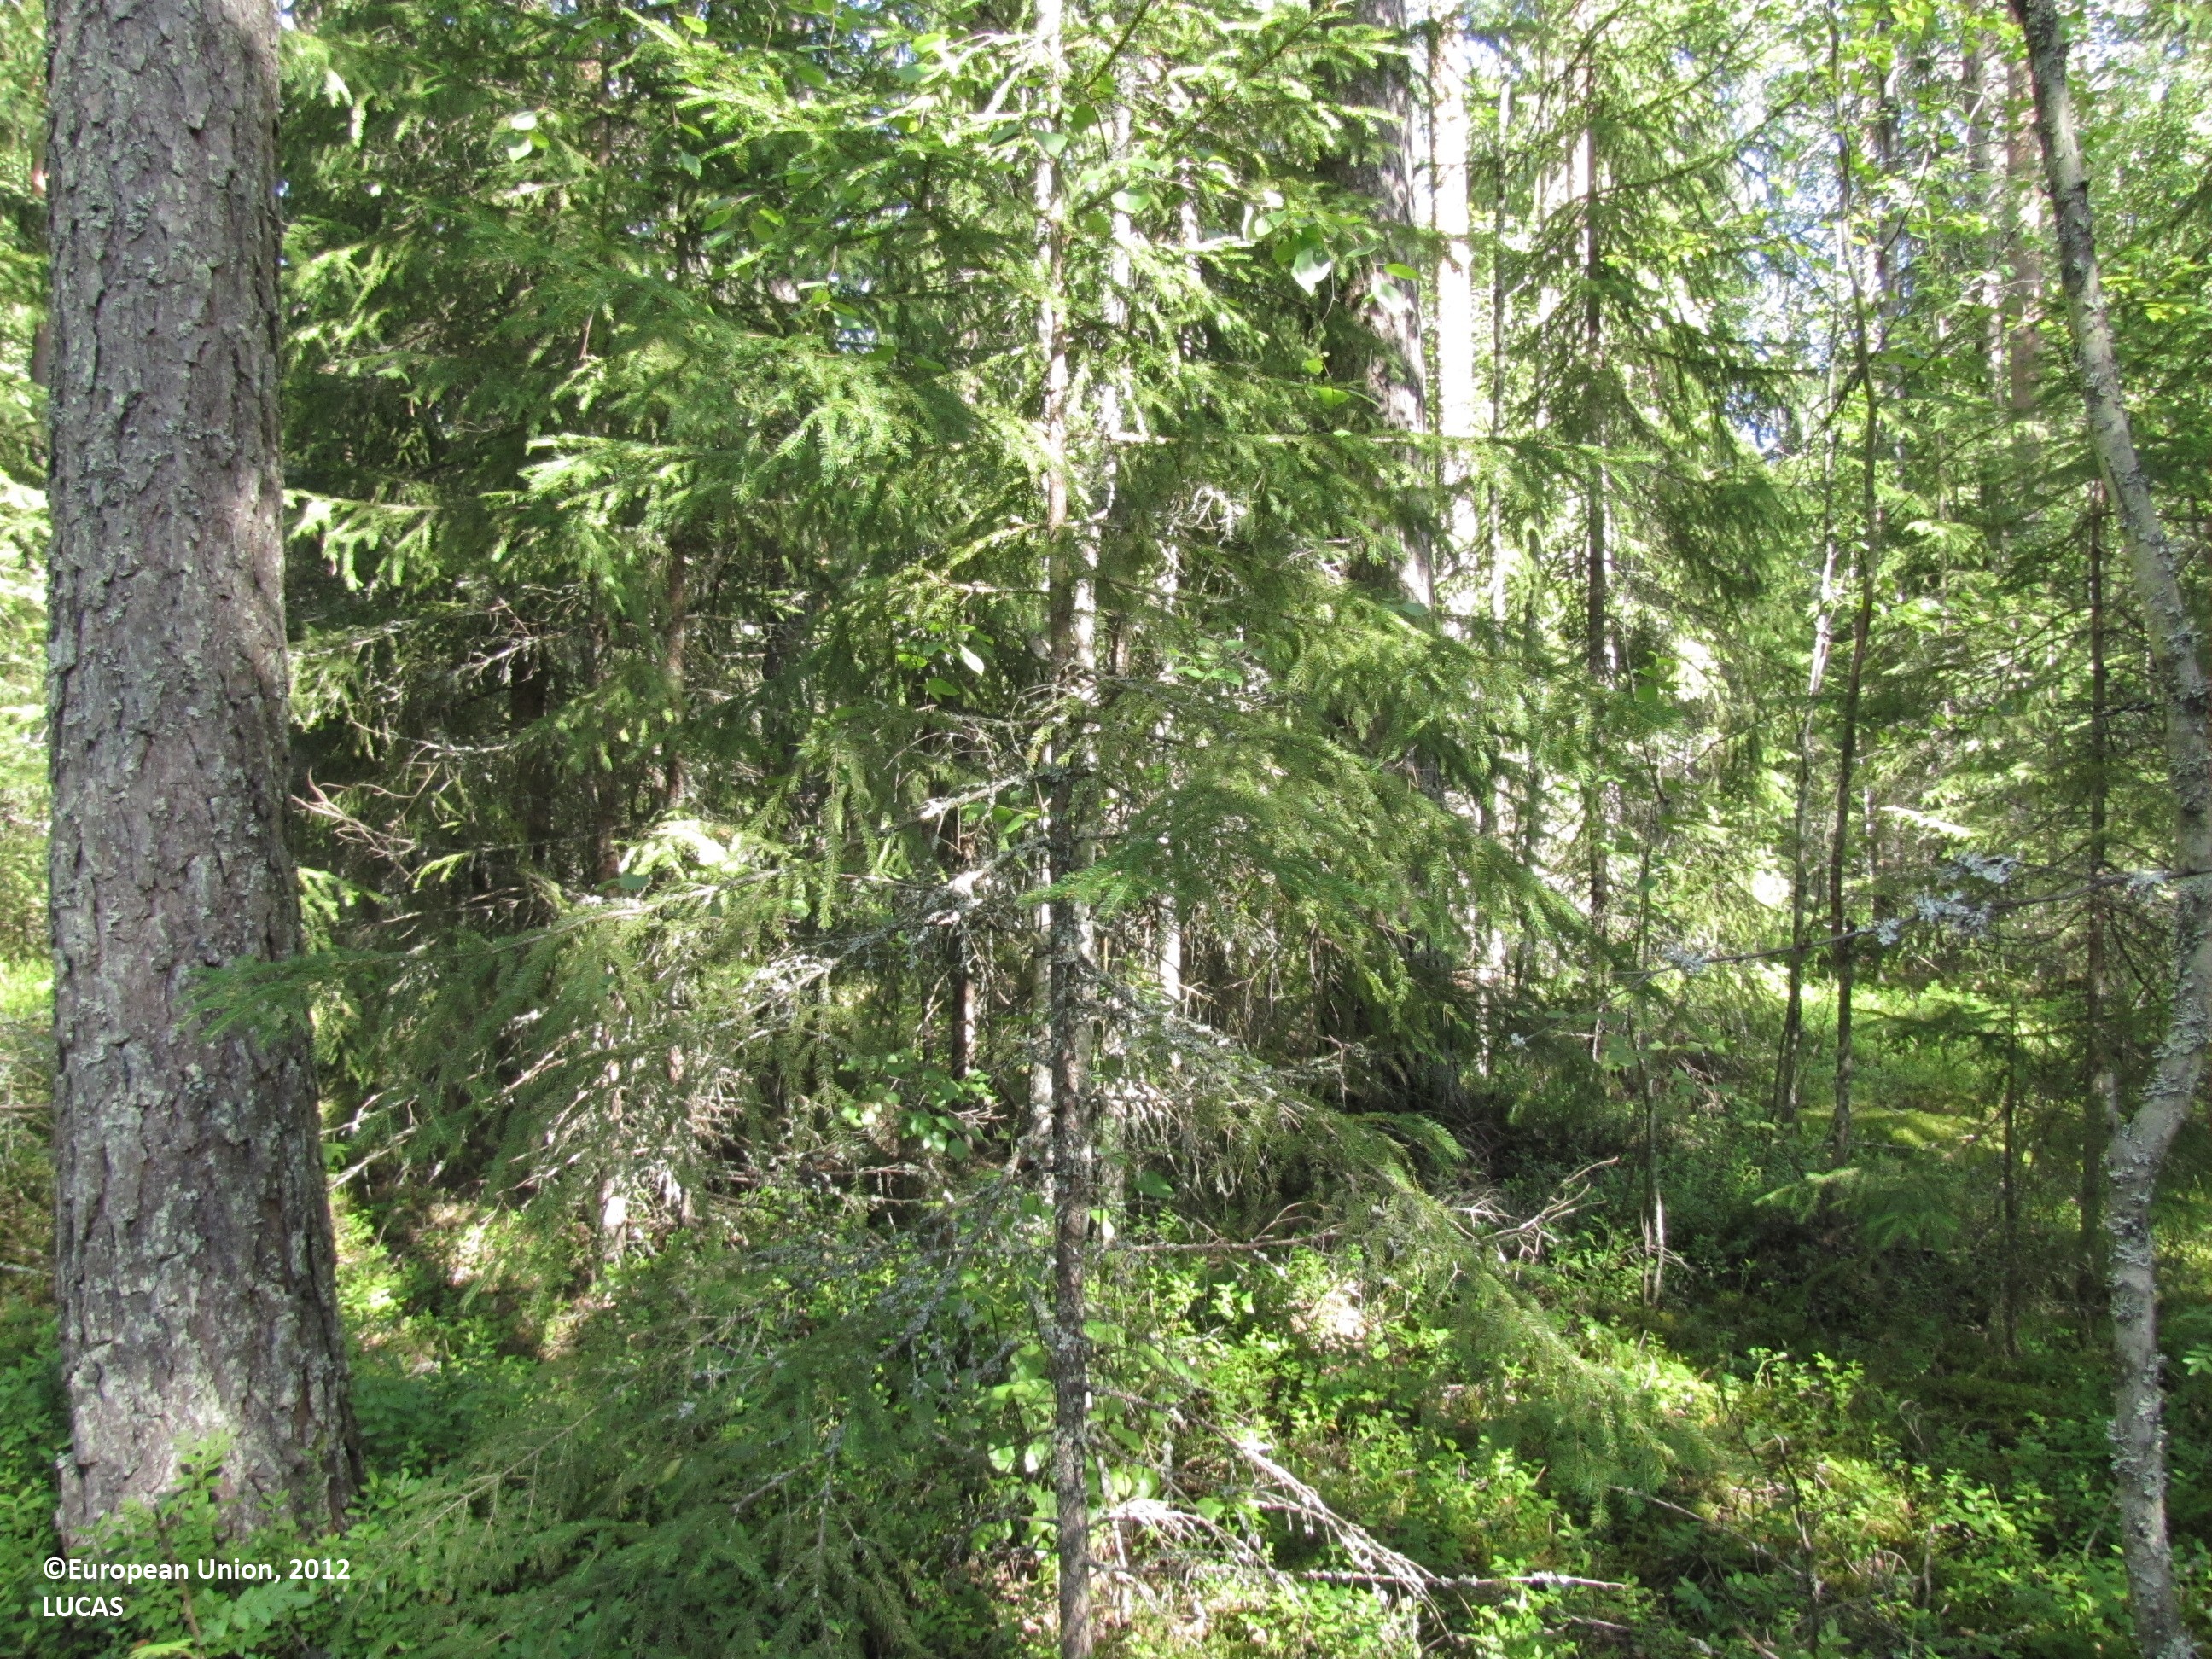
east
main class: Woodland
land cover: Pine dominated coniferous woodland
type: boreal forest
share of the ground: > 75 %
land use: Forestry
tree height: > 5 m
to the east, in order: Pine dominated coniferous woodland; Spruce dominated mixed woodland; Ditches and canals; Other mixed woodland; Pine dominated coniferous woodland; Ditches and canals; Pine dominated coniferous woodland; Ditches and canals; Pine dominated coniferous woodland
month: July
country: FI
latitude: 62.3515
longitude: 23.0654
